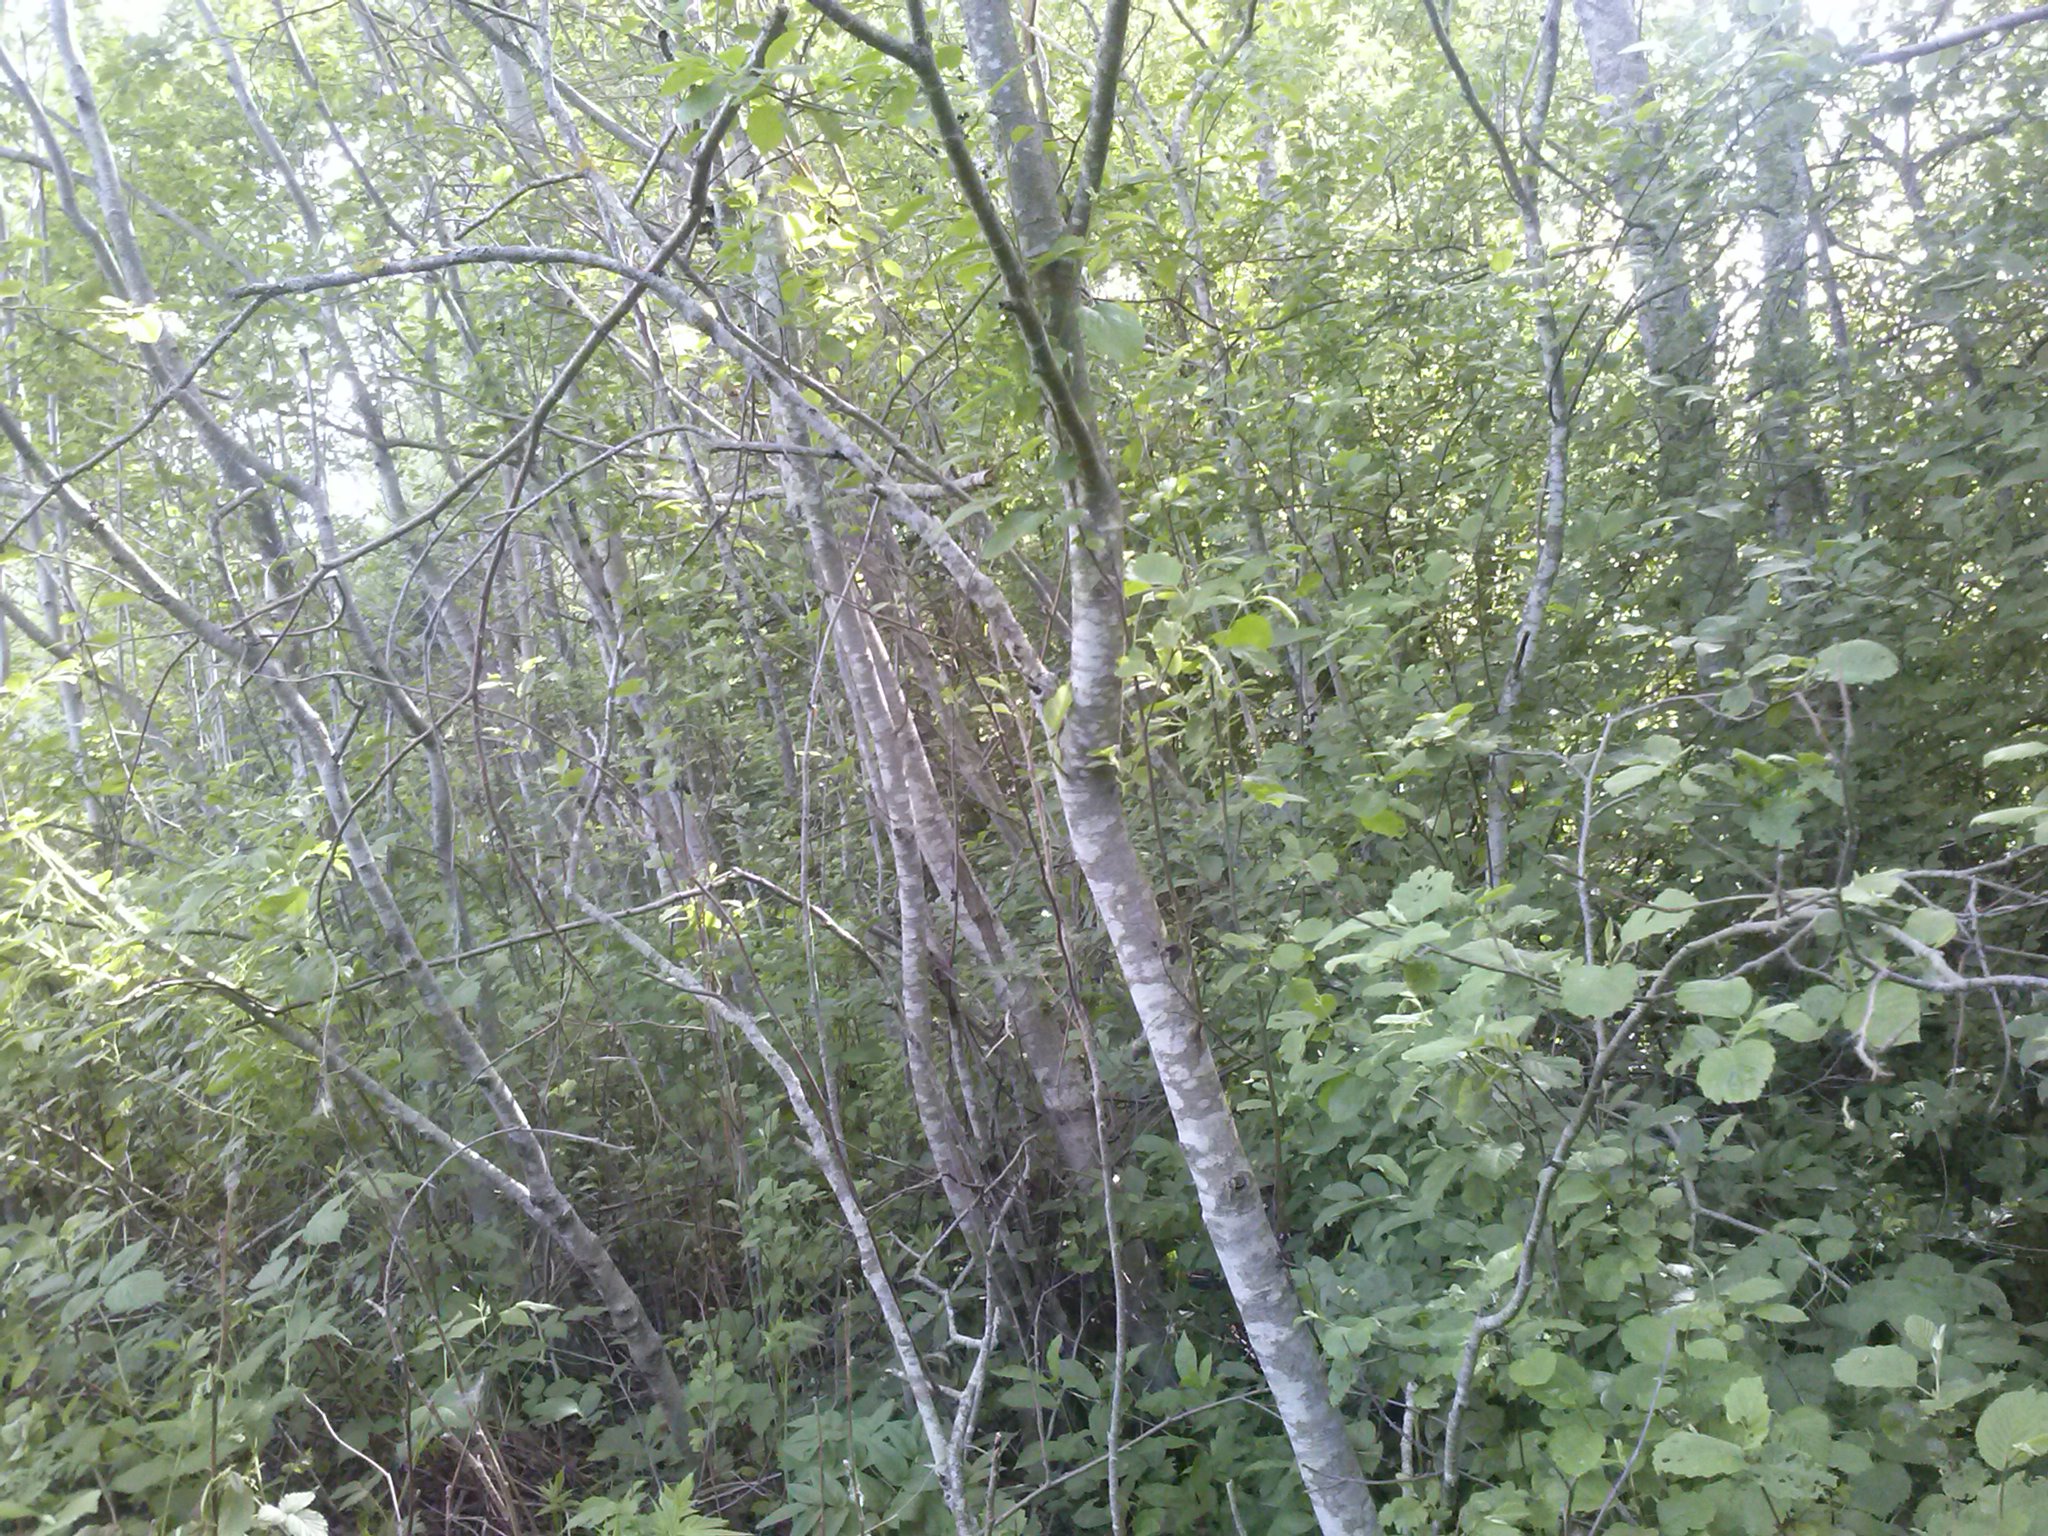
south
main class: Woodland
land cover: Broadleaved woodland
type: non-riverine alder, birch or aspen forest
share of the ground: > 75 %
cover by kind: broadleaved forest trees 100 %
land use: Forestry
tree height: > 5 m
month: June
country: LV
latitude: 56.3036
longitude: 26.7879
